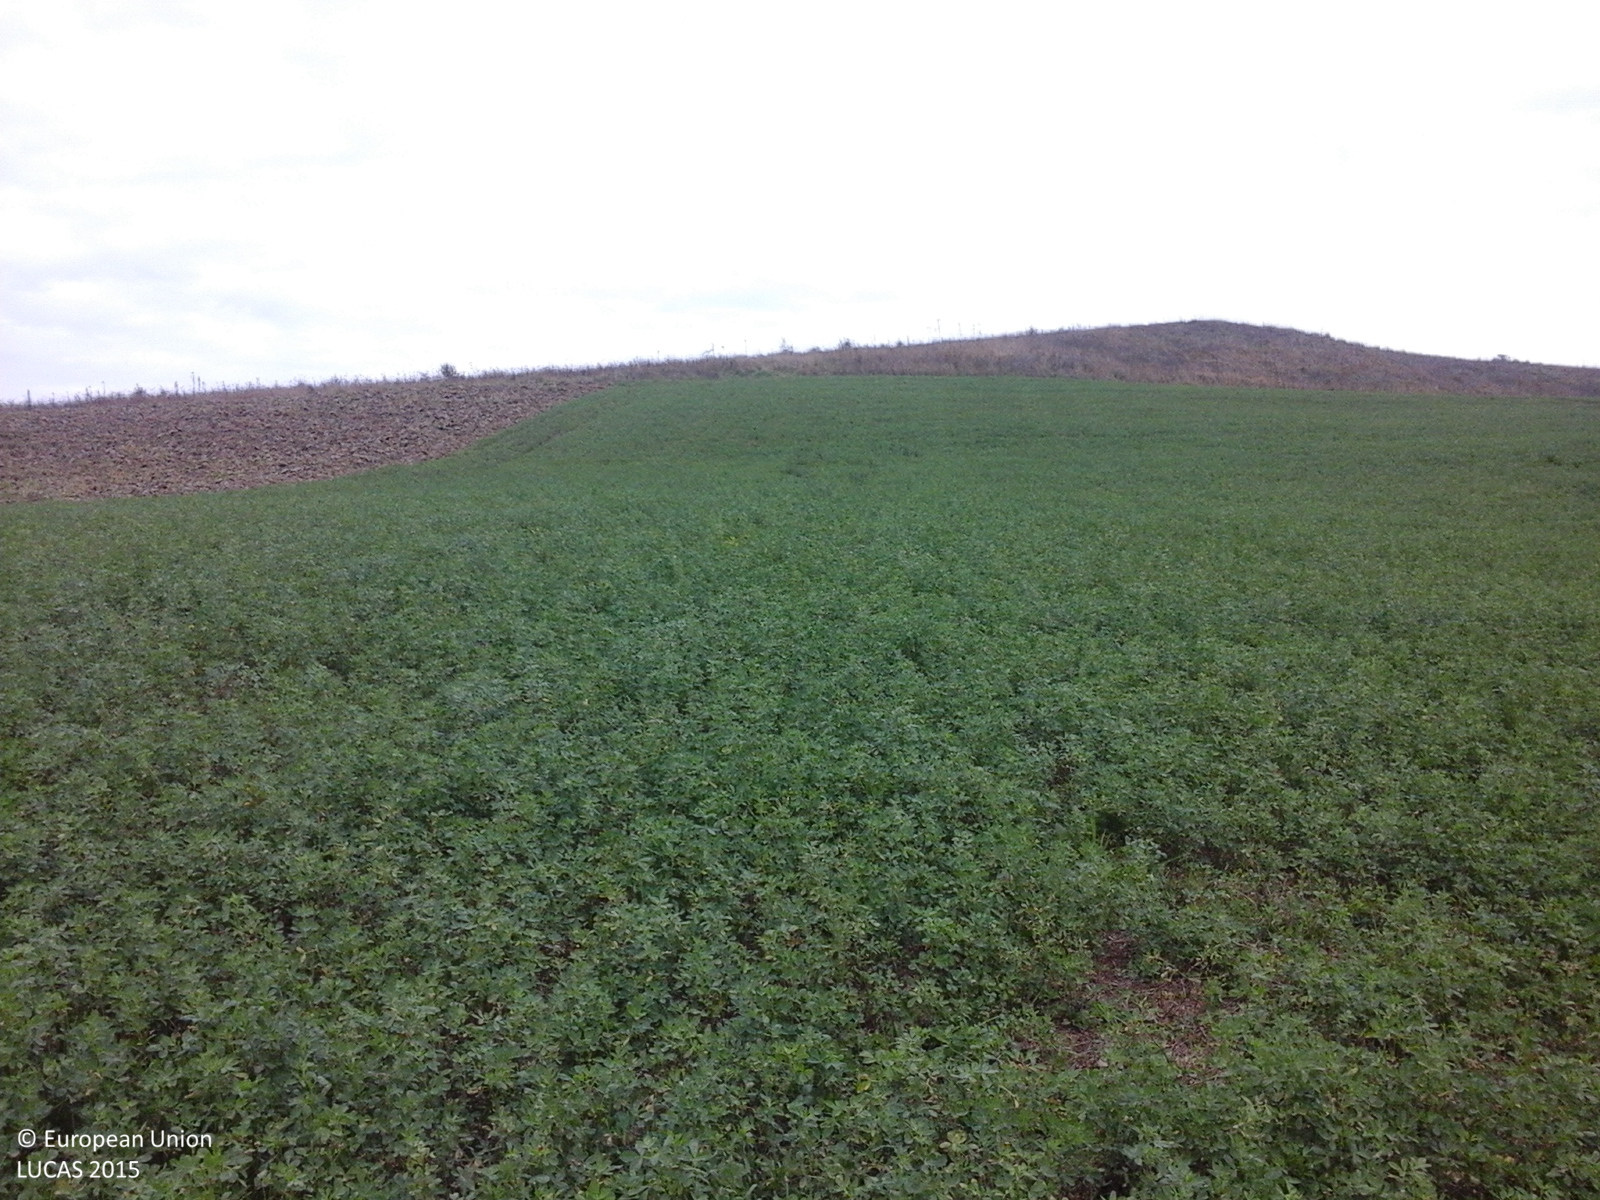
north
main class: Cropland
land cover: Lucerne
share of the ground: > 75 %
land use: Agriculture (excluding fallow land and kitchen gardens)
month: October
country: RO
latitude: 46.3544
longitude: 25.0821
